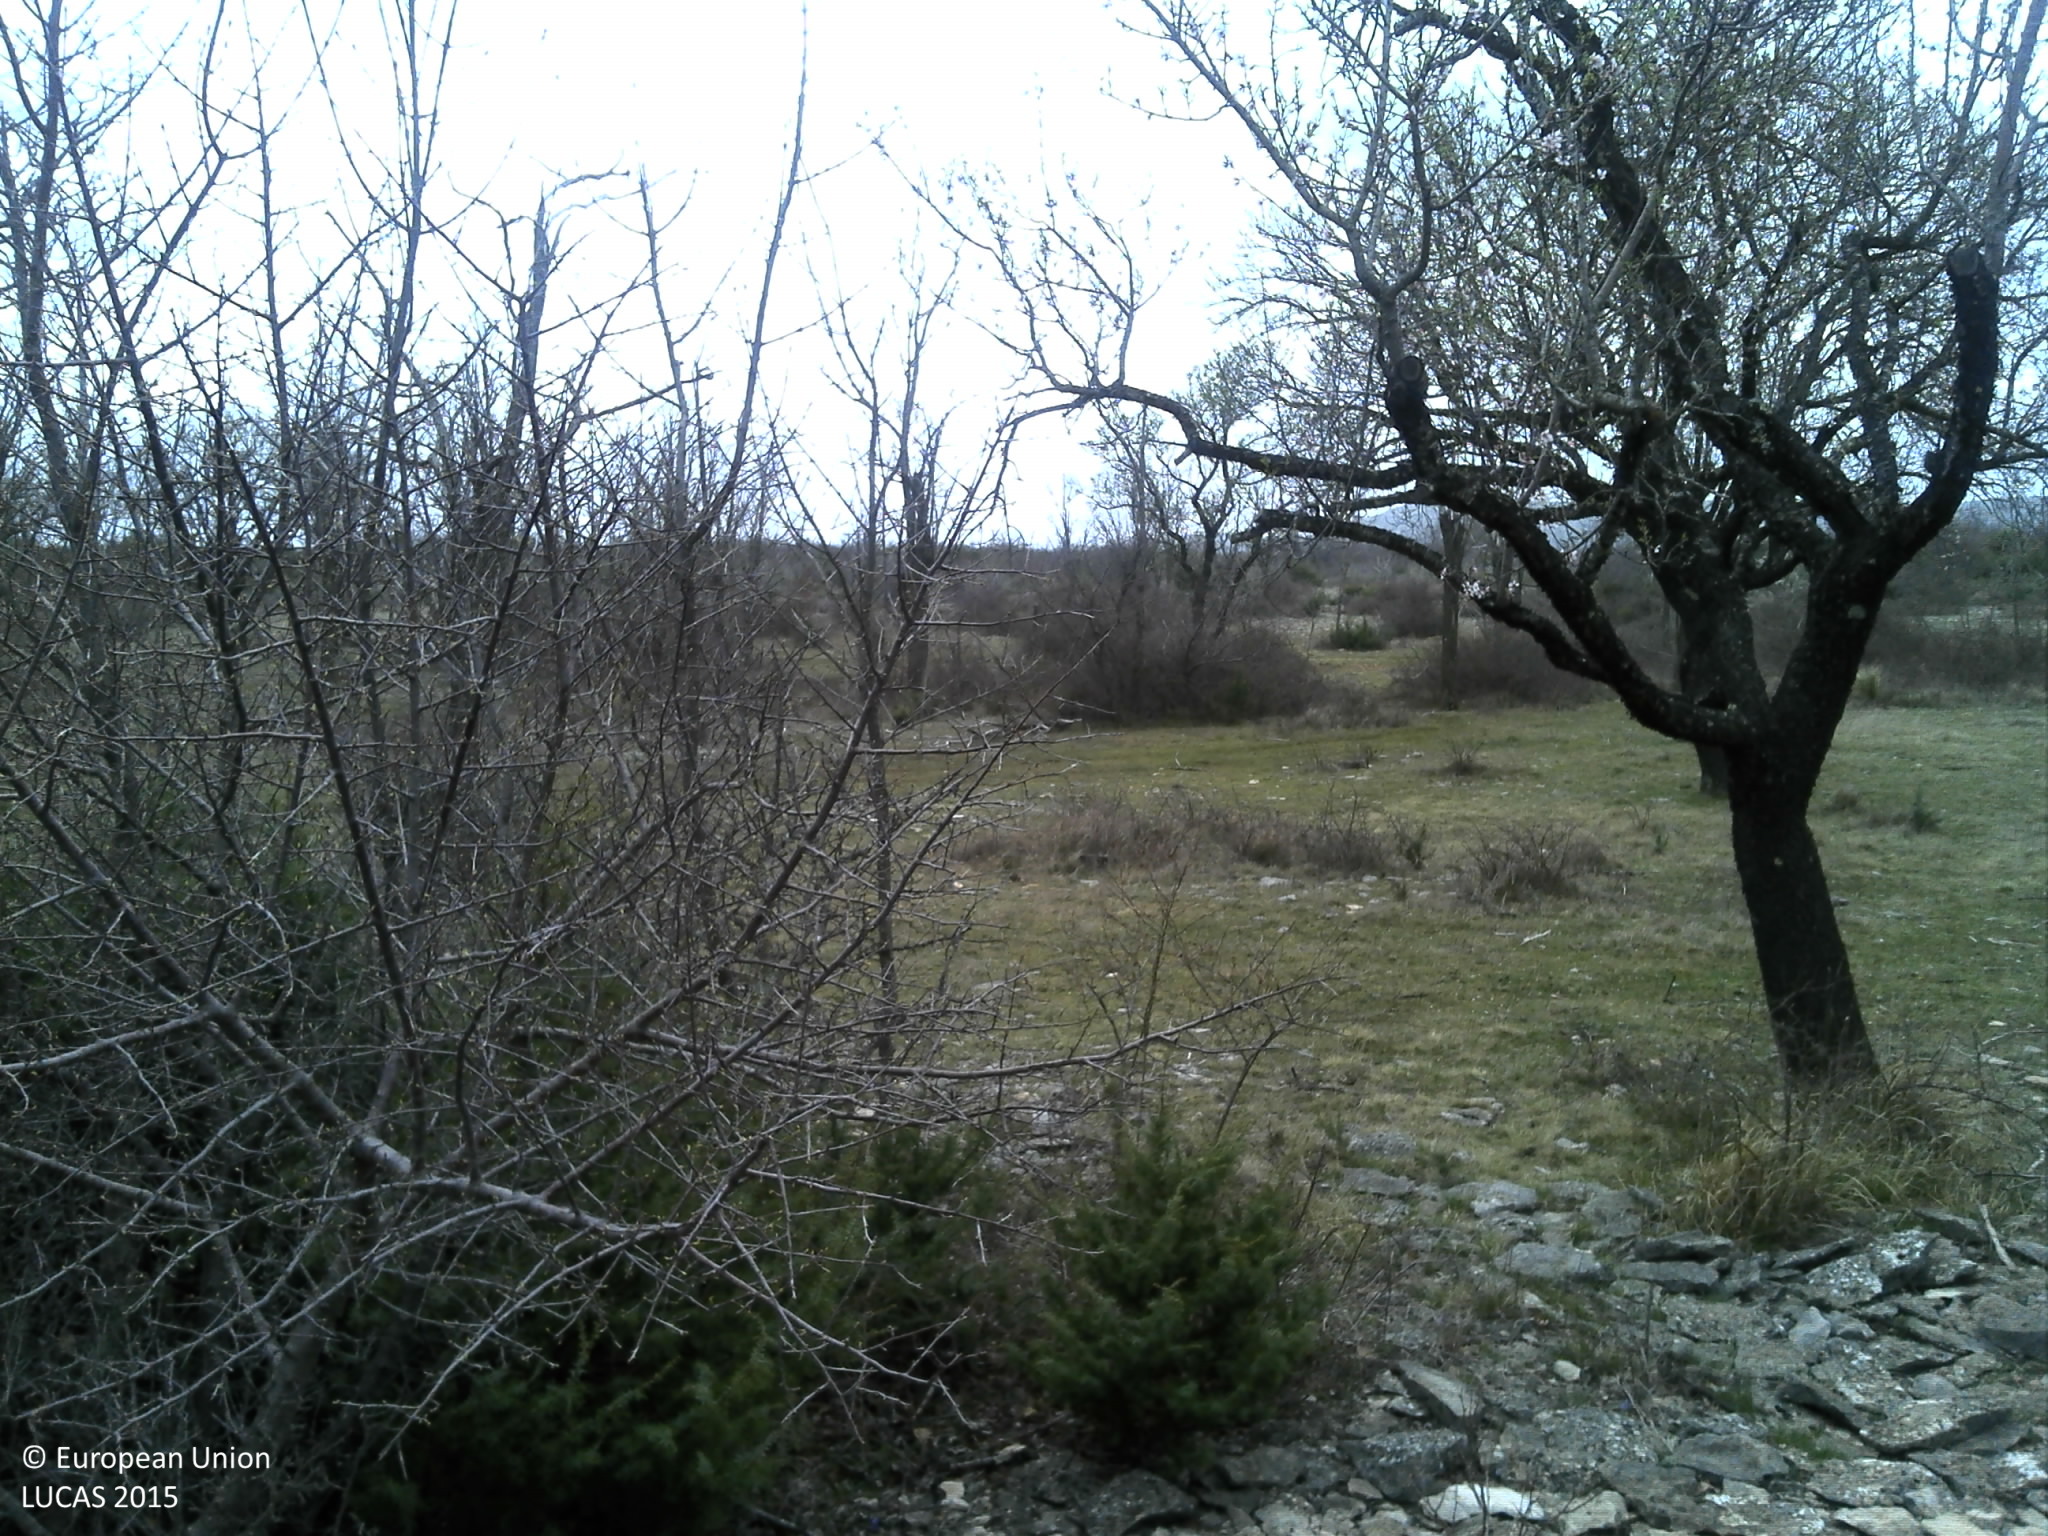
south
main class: Woodland
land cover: Broadleaved woodland
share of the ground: 25 - 50 %
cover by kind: unconsolidated bare surface 35 %, broadleaved forest trees 25 %, shrubs 25 %, herbaceous plants 15 %
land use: Semi-natural and natural areas not in use
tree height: < 5 m
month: March
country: HR
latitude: 43.9872
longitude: 15.8395
